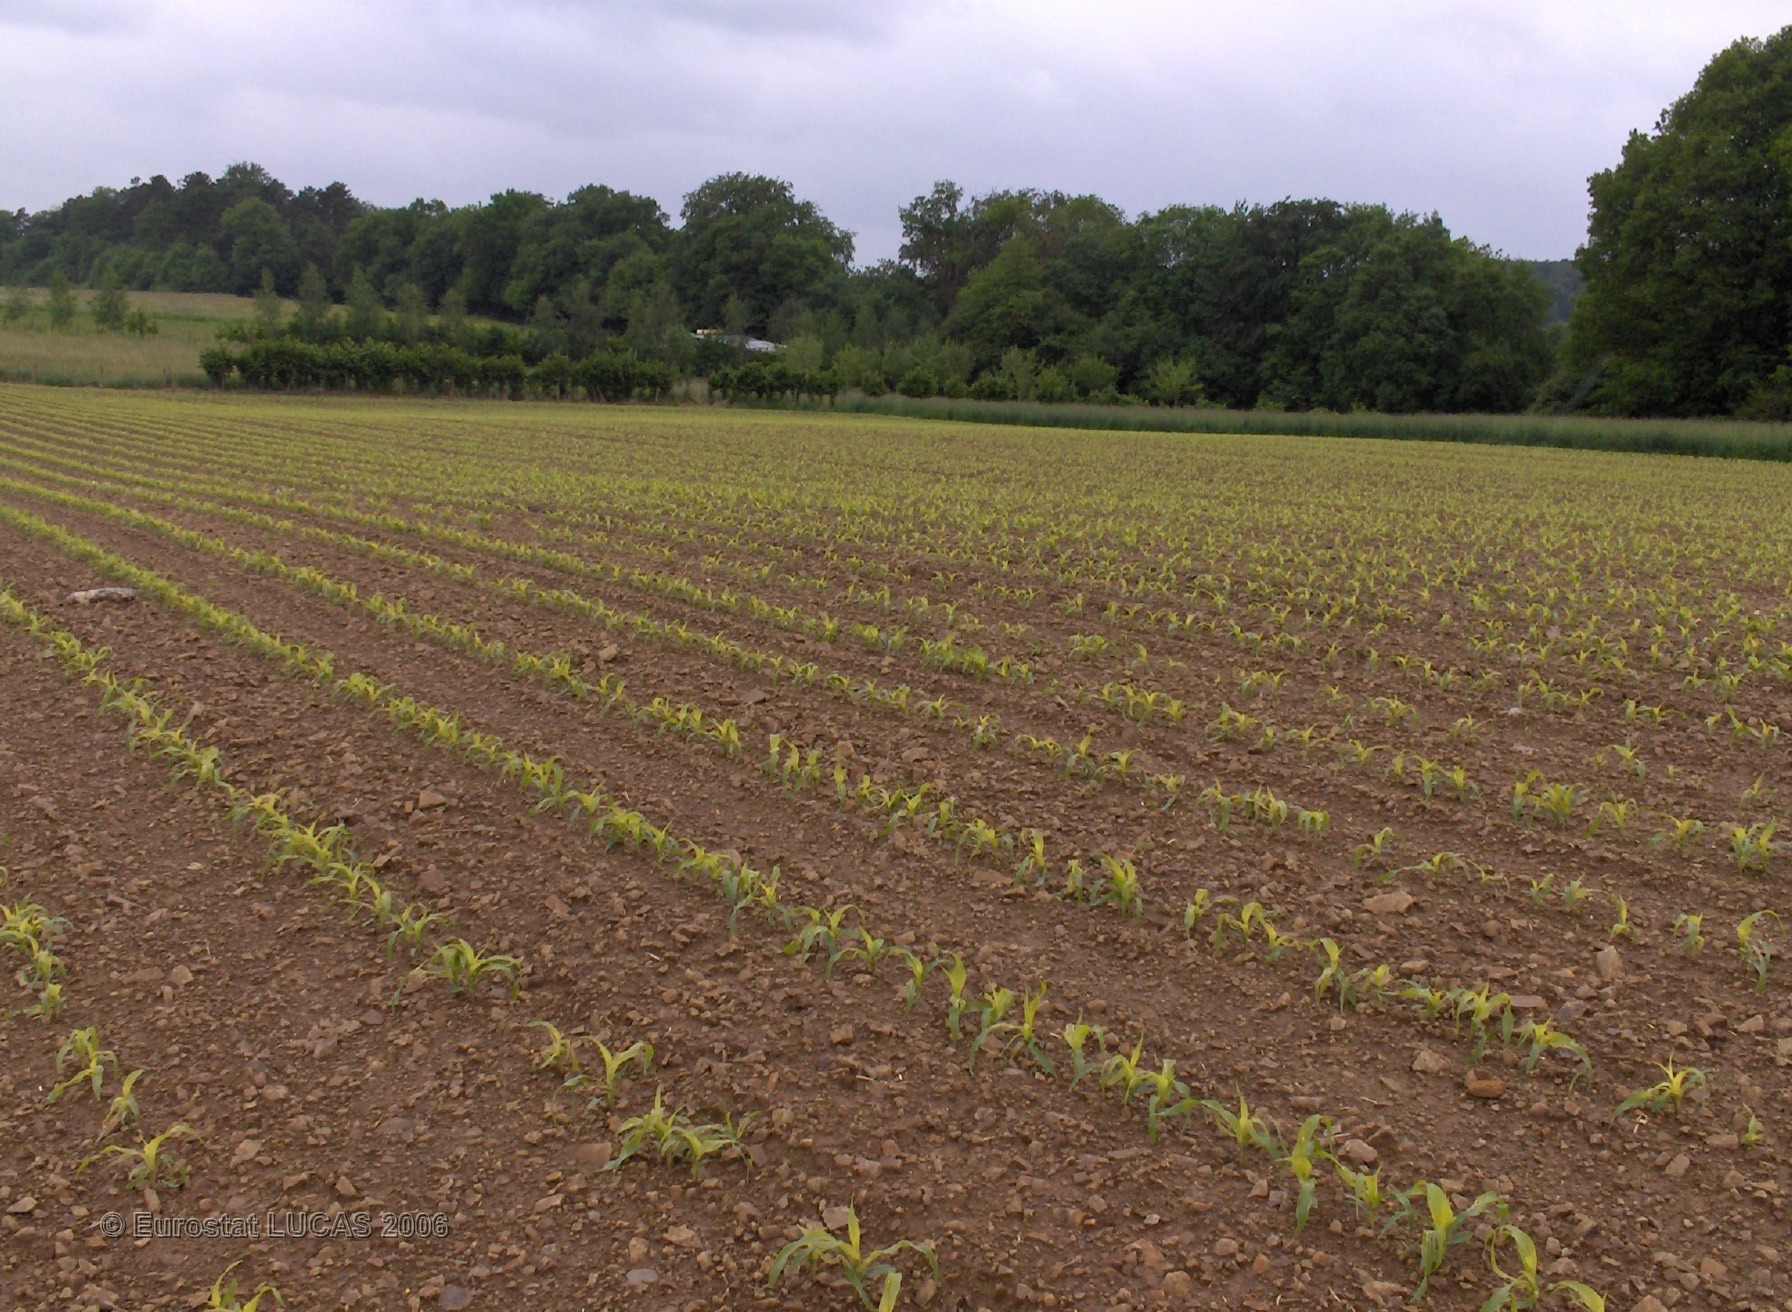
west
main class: Cropland
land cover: Maize
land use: Agriculture (excluding fallow land and kitchen gardens)
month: June
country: BE
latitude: 50.1575
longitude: 5.2528
